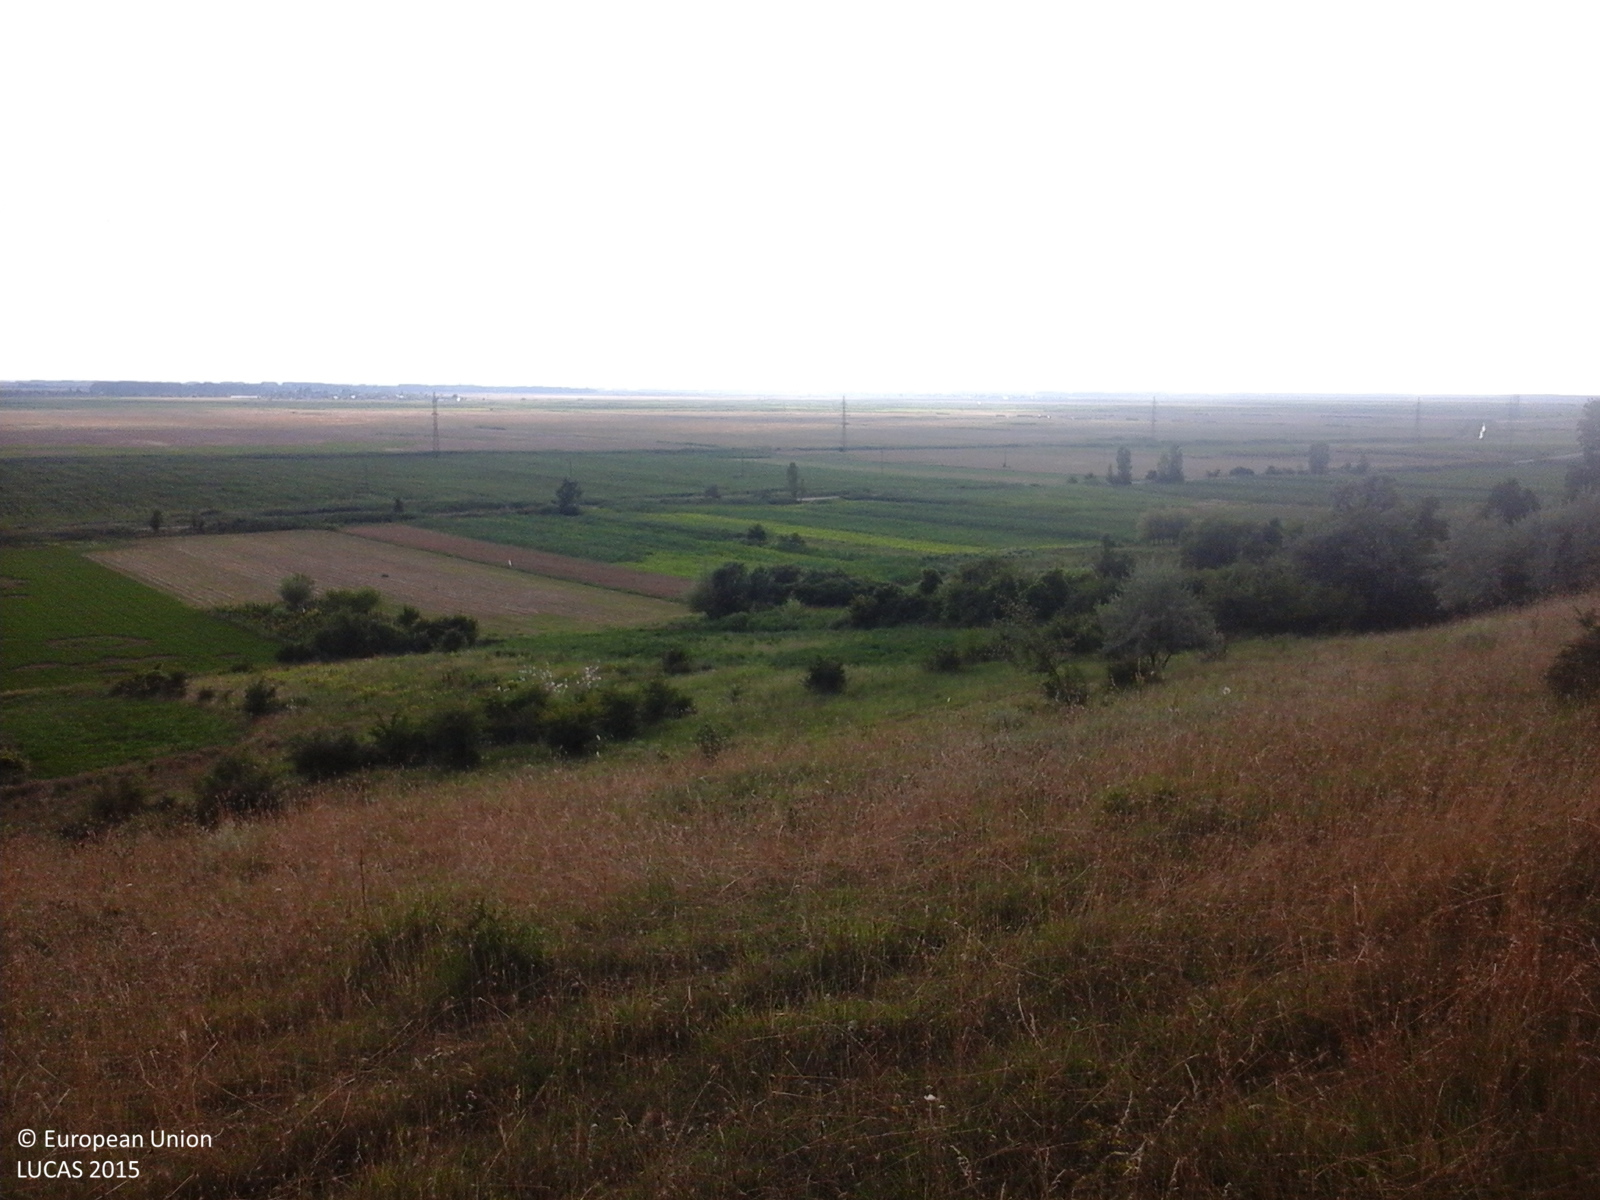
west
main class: Grassland
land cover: Grassland with sparse tree/shrub cover
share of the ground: > 75 %
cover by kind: herbaceous plants 85 %, shrubs 10 %, broadleaved forest trees 5 %
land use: Agriculture (excluding fallow land and kitchen gardens)
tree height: < 5 m
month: July
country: RO
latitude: 44.1166
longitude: 24.6016
